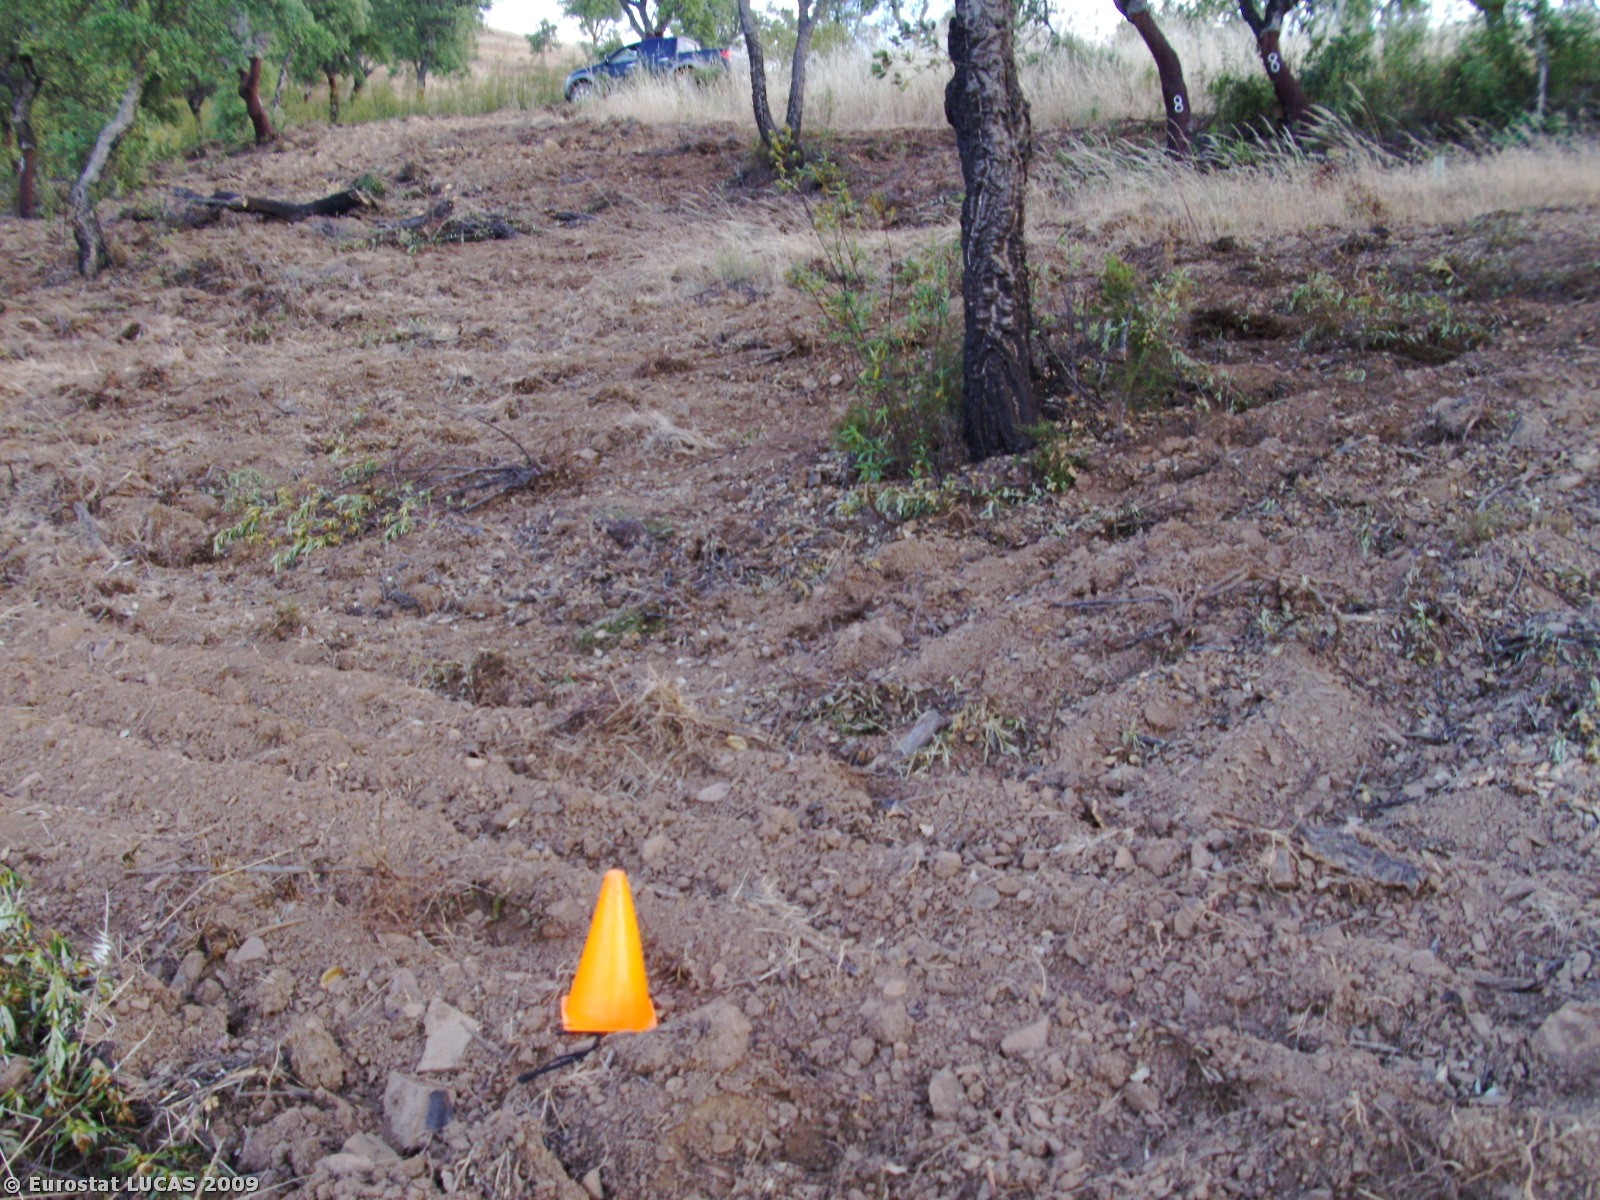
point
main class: Woodland
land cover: Broadleaved woodland
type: broadleaved evergreen forest
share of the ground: 10 - 25 %
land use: Forestry
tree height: > 5 m
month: June
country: PT
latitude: 37.1831
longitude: -8.7412
